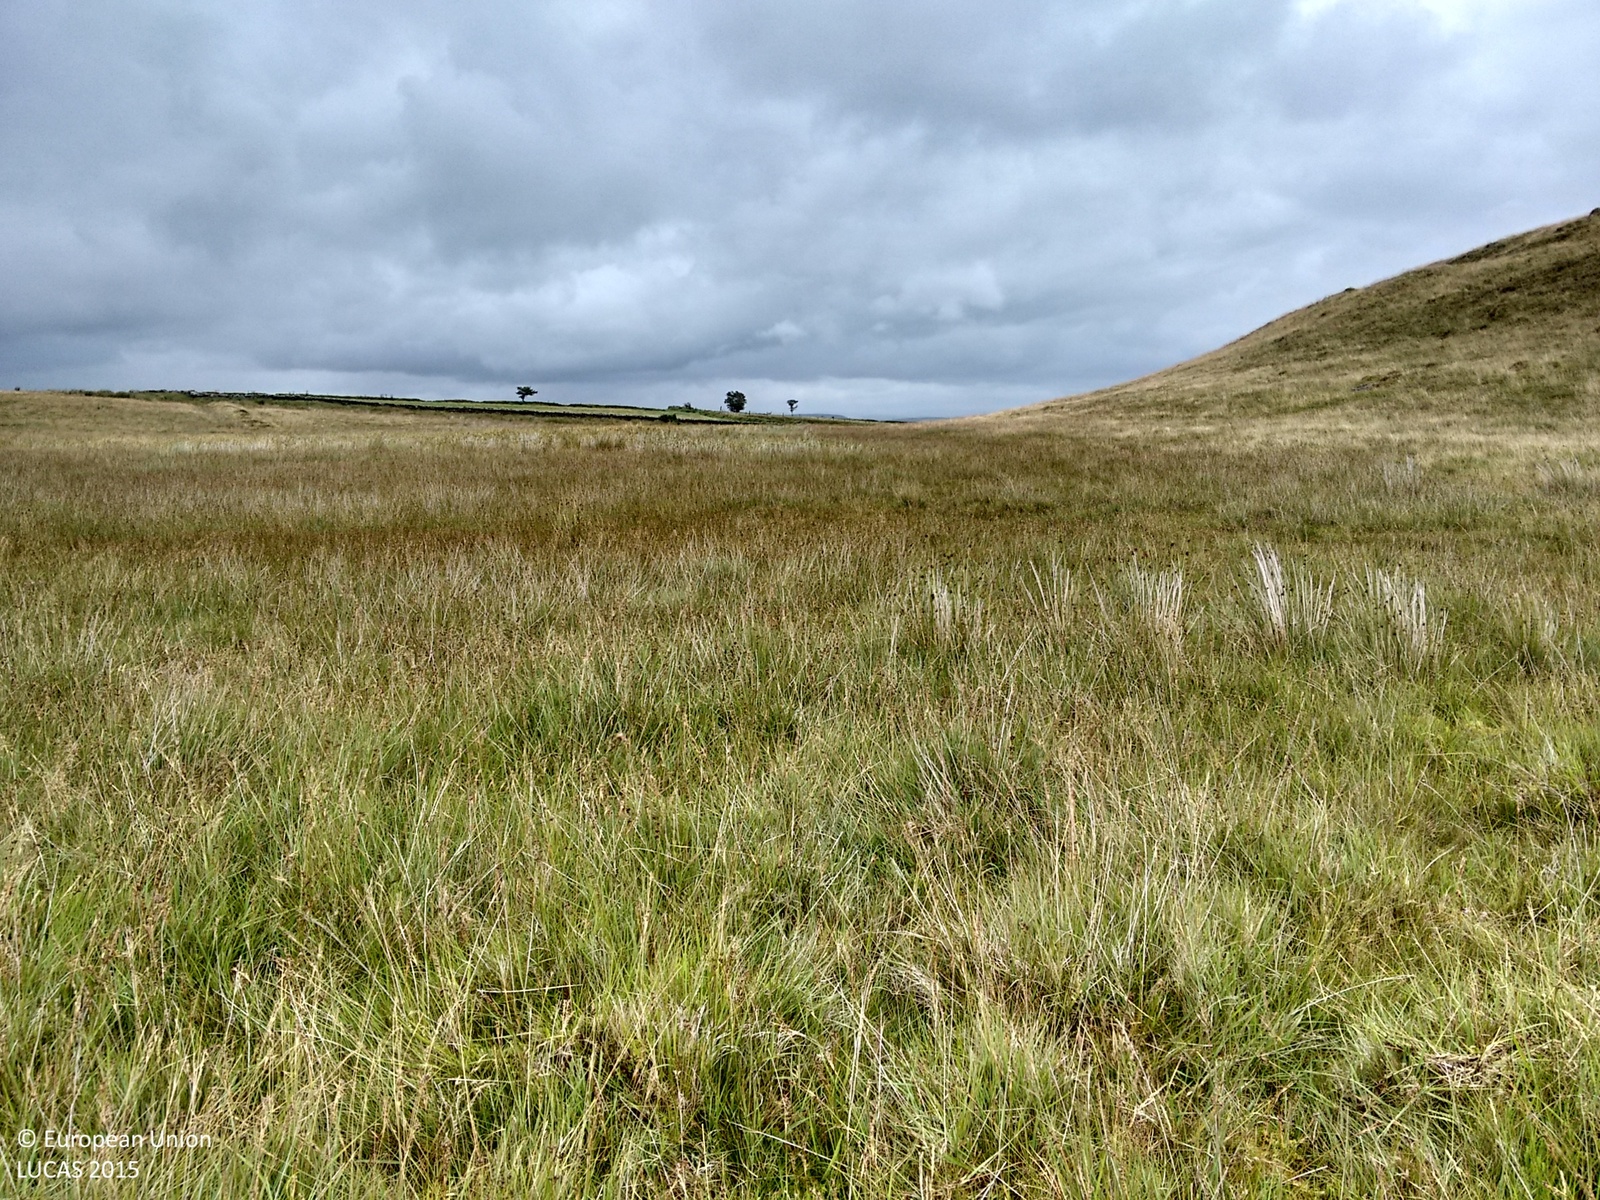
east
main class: Grassland
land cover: Grassland without tree/shrub cover
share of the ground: > 75 %
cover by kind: herbaceous plants 100 %
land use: Agriculture (excluding fallow land and kitchen gardens)
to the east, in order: Grassland without tree/shrub cover; Tracks; Grassland without tree/shrub cover; Dry stone walls; Shruby margins; Grassland without tree/shrub cover
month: July
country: GB
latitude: 51.7621
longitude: -3.8414
